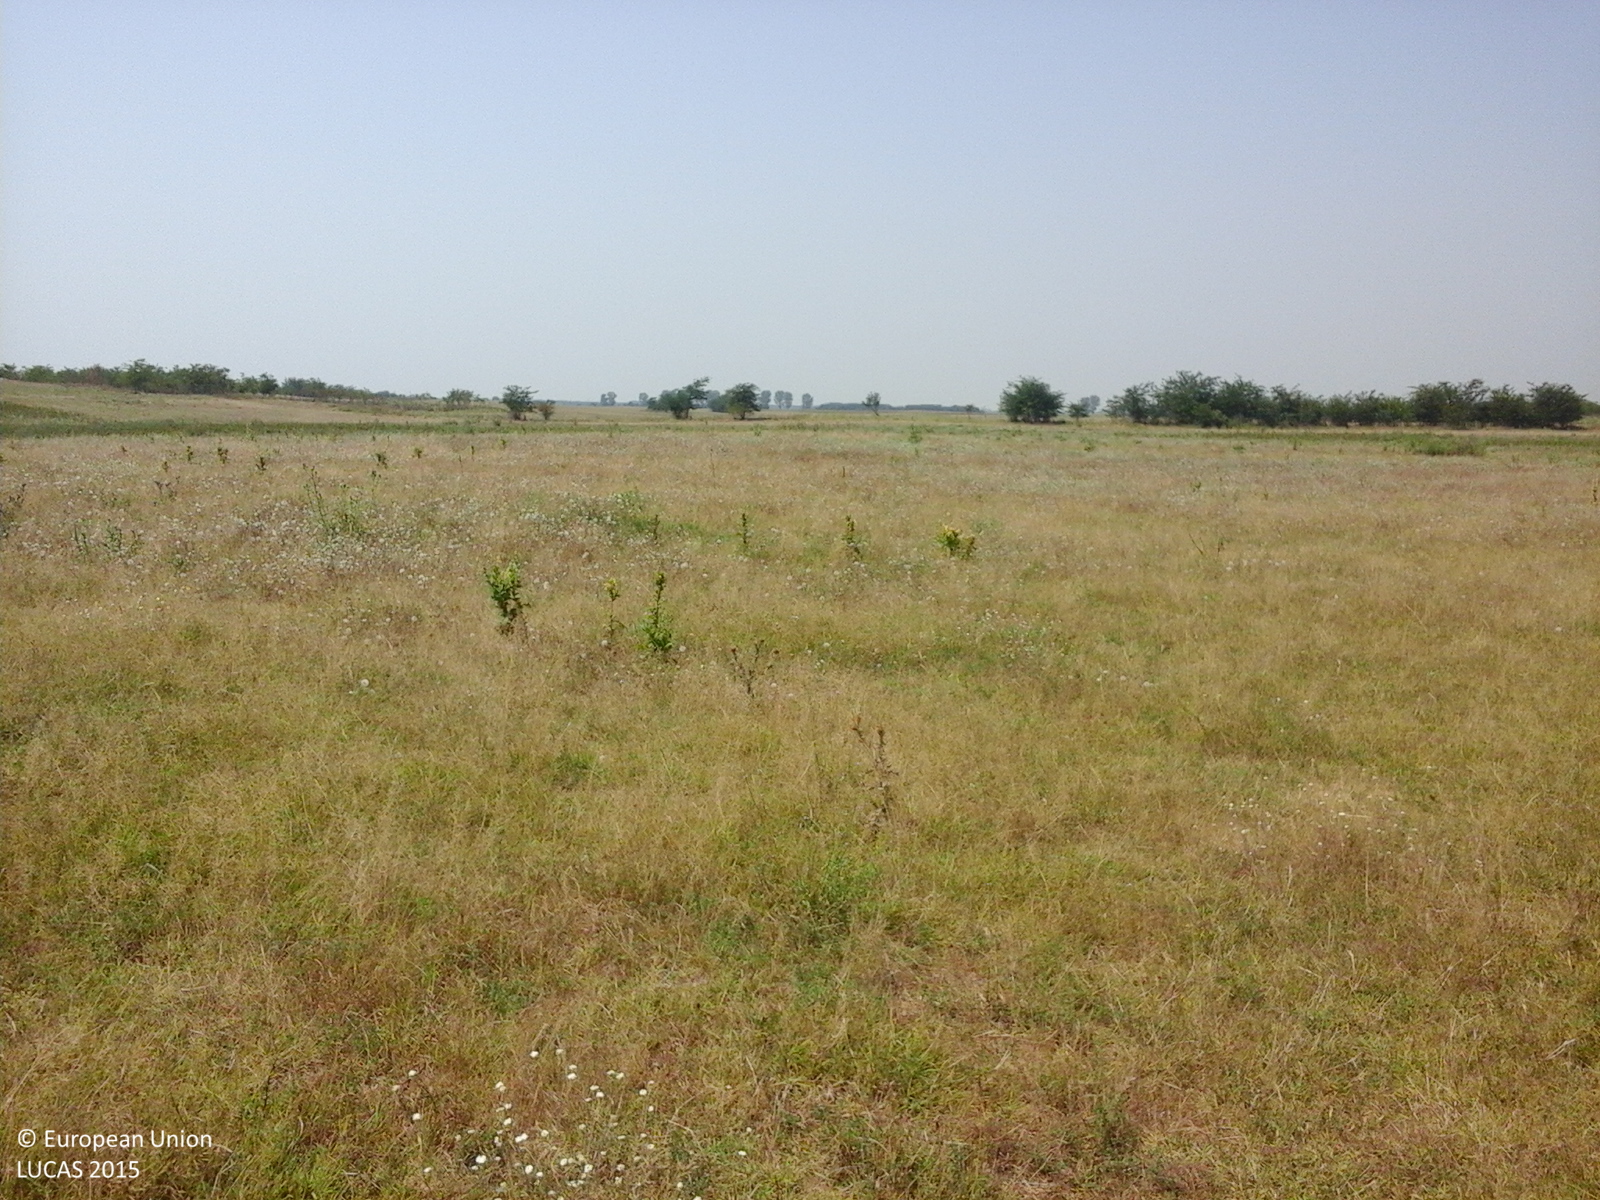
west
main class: Grassland
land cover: Grassland without tree/shrub cover
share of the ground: > 75 %
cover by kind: herbaceous plants 100 %
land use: Agriculture (excluding fallow land and kitchen gardens)
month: August
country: RO
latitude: 43.8542
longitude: 23.1674
